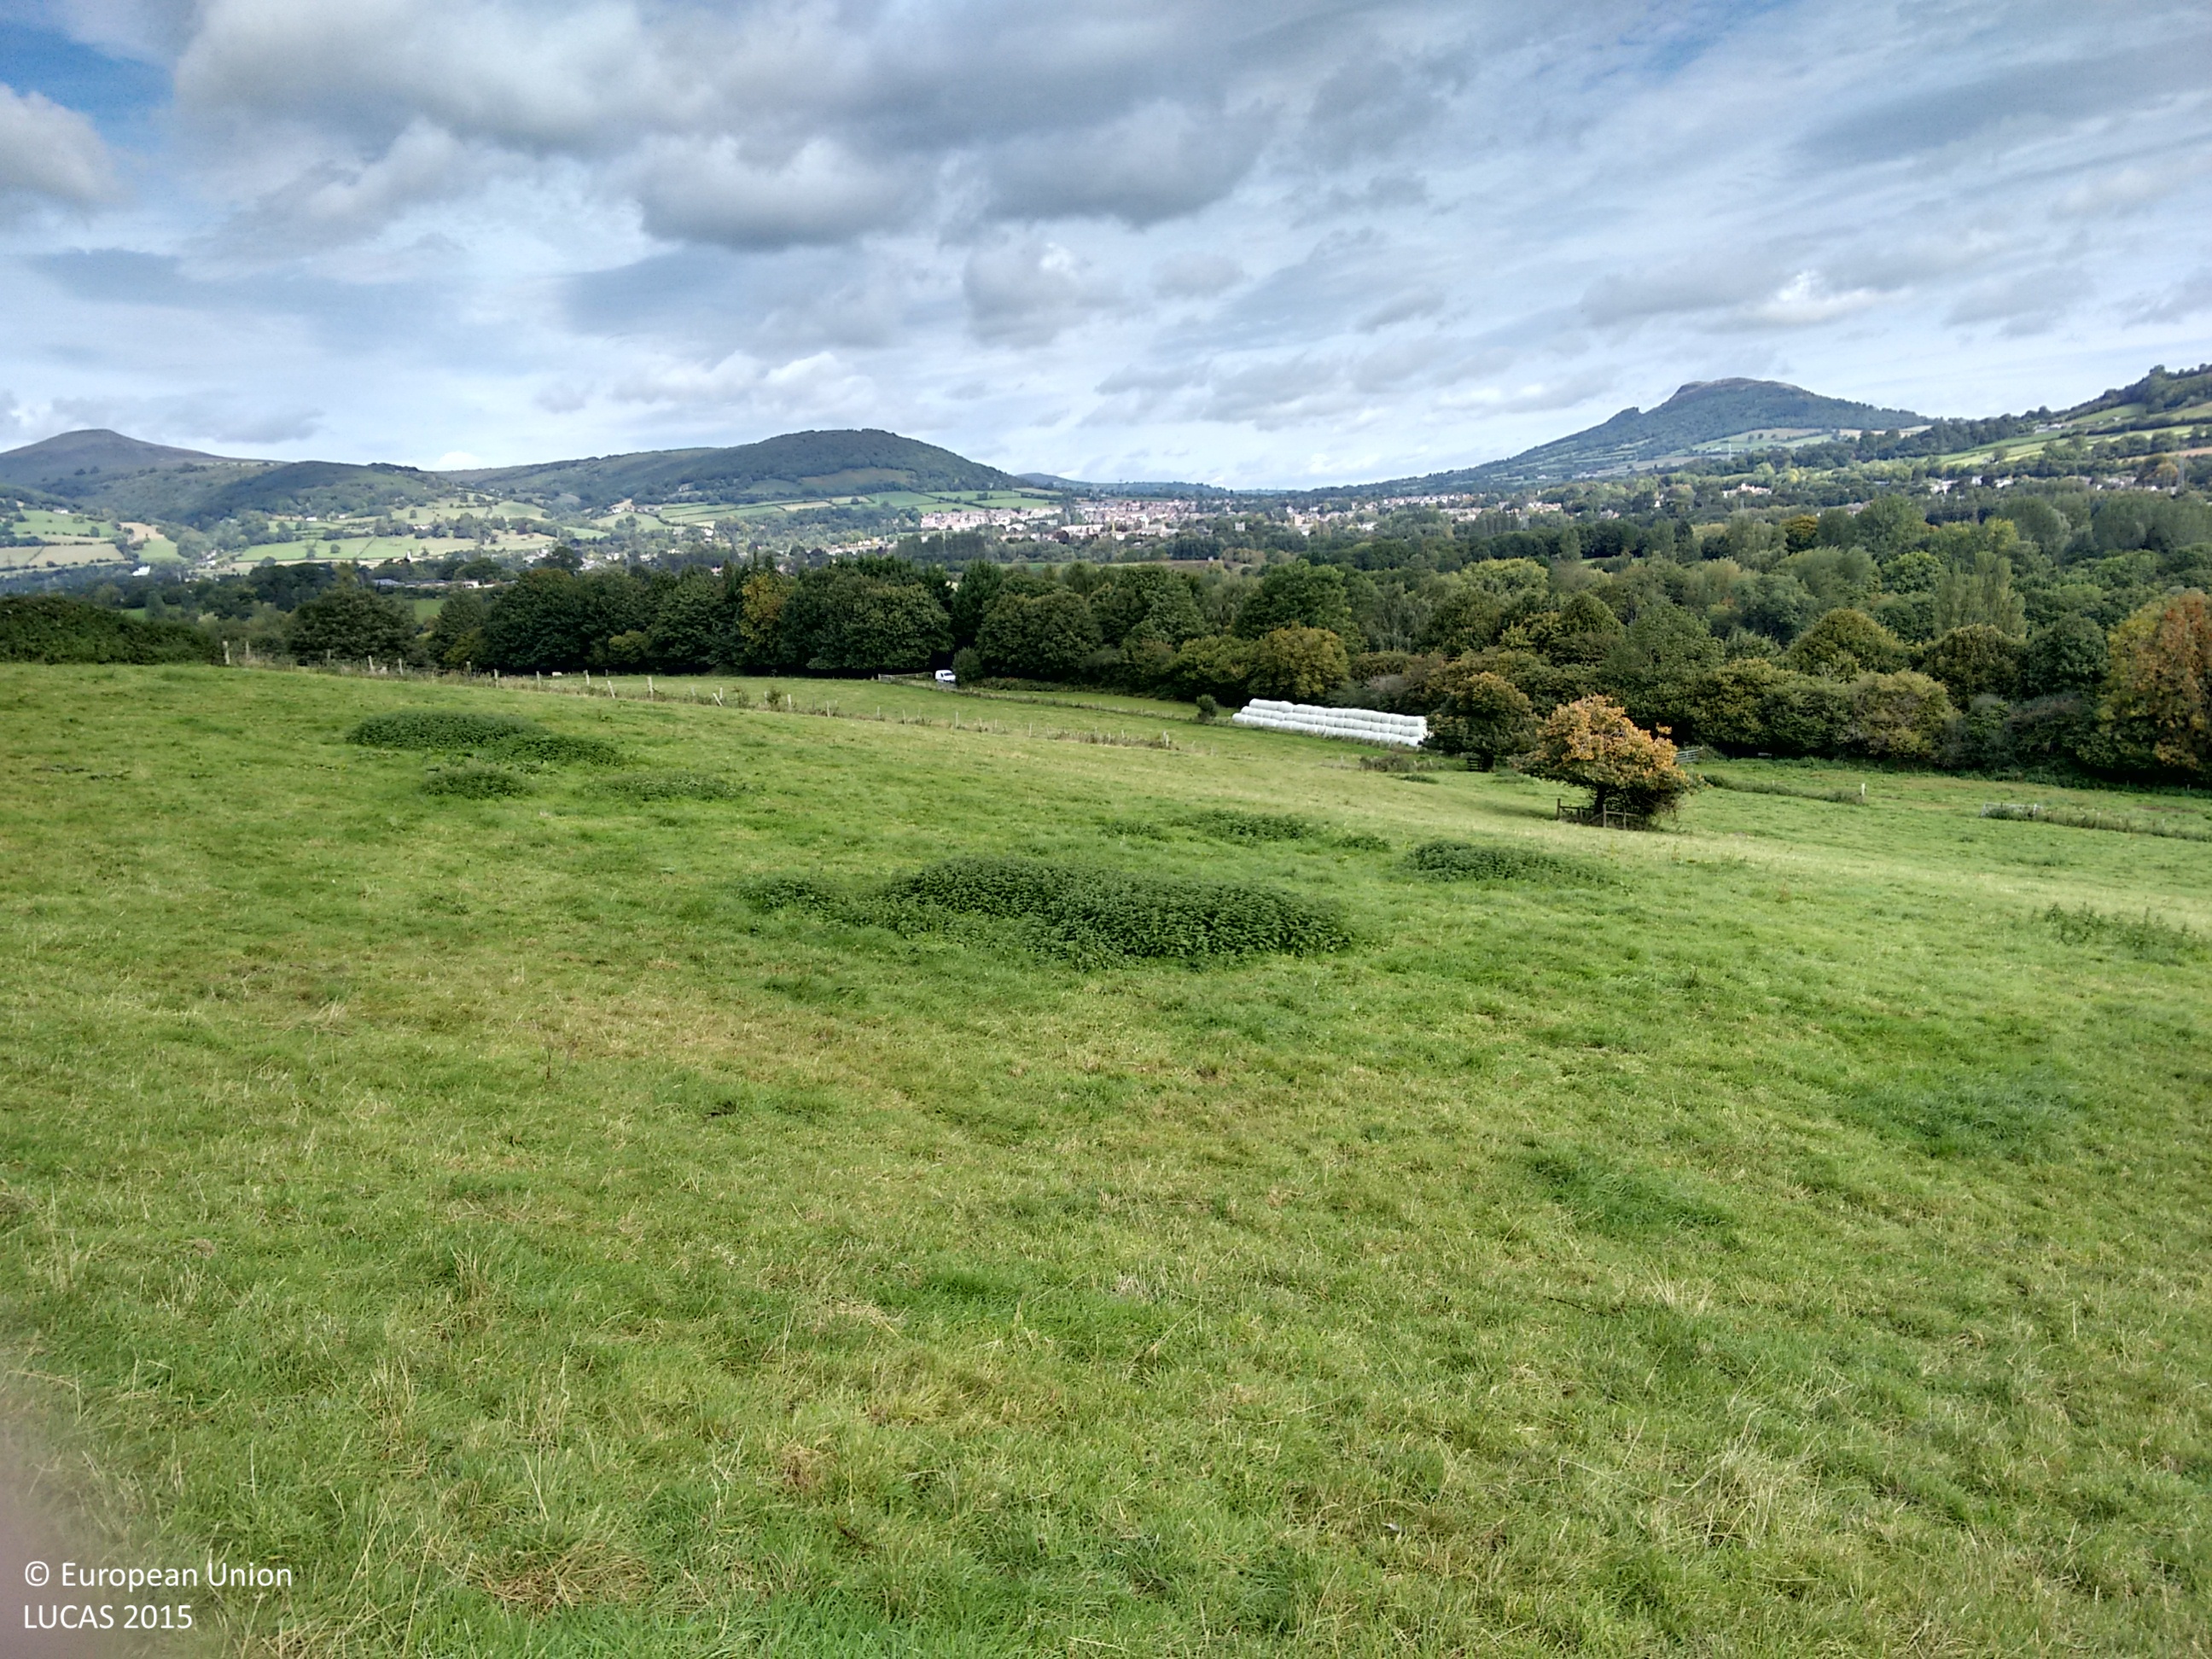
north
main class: Grassland
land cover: Grassland without tree/shrub cover
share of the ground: > 75 %
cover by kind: herbaceous plants 100 %
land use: Agriculture (excluding fallow land and kitchen gardens)
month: September
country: GB
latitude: 51.8016
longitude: -3.0256
